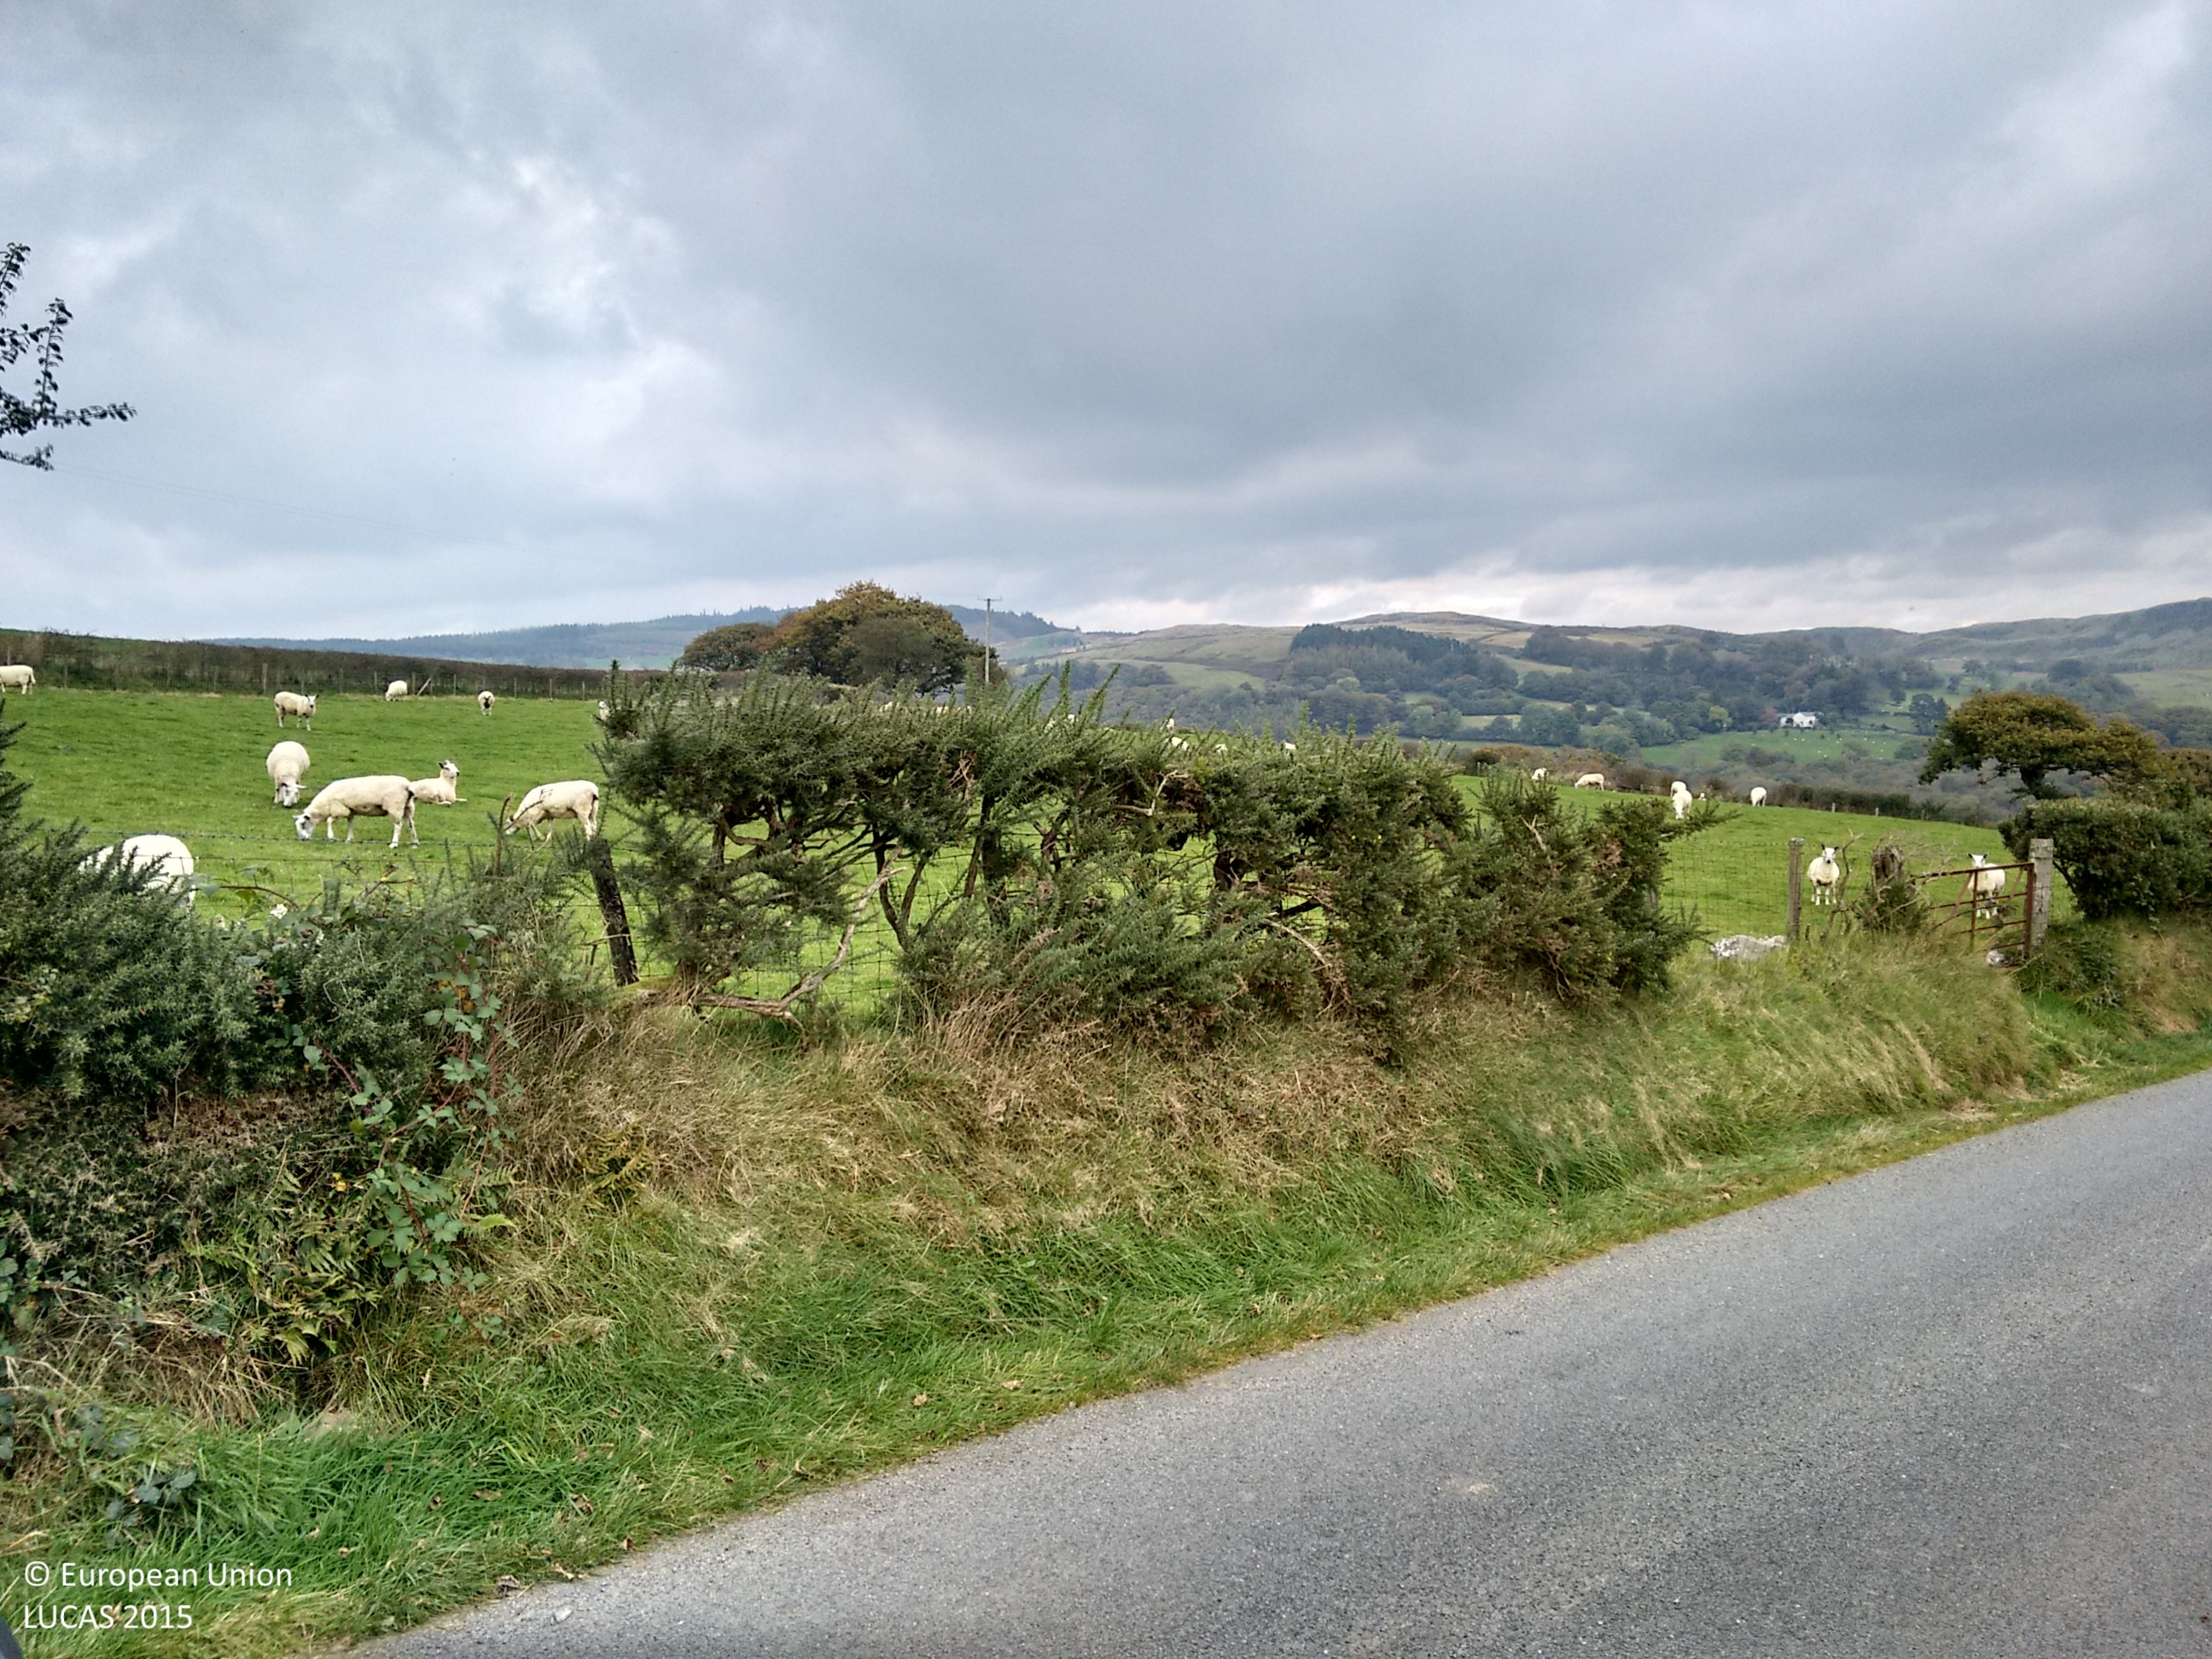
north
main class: Grassland
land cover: Grassland without tree/shrub cover
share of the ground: > 75 %
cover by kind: herbaceous plants 100 %
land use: Agriculture (excluding fallow land and kitchen gardens)
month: October
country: GB
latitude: 52.3003
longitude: -3.9214
